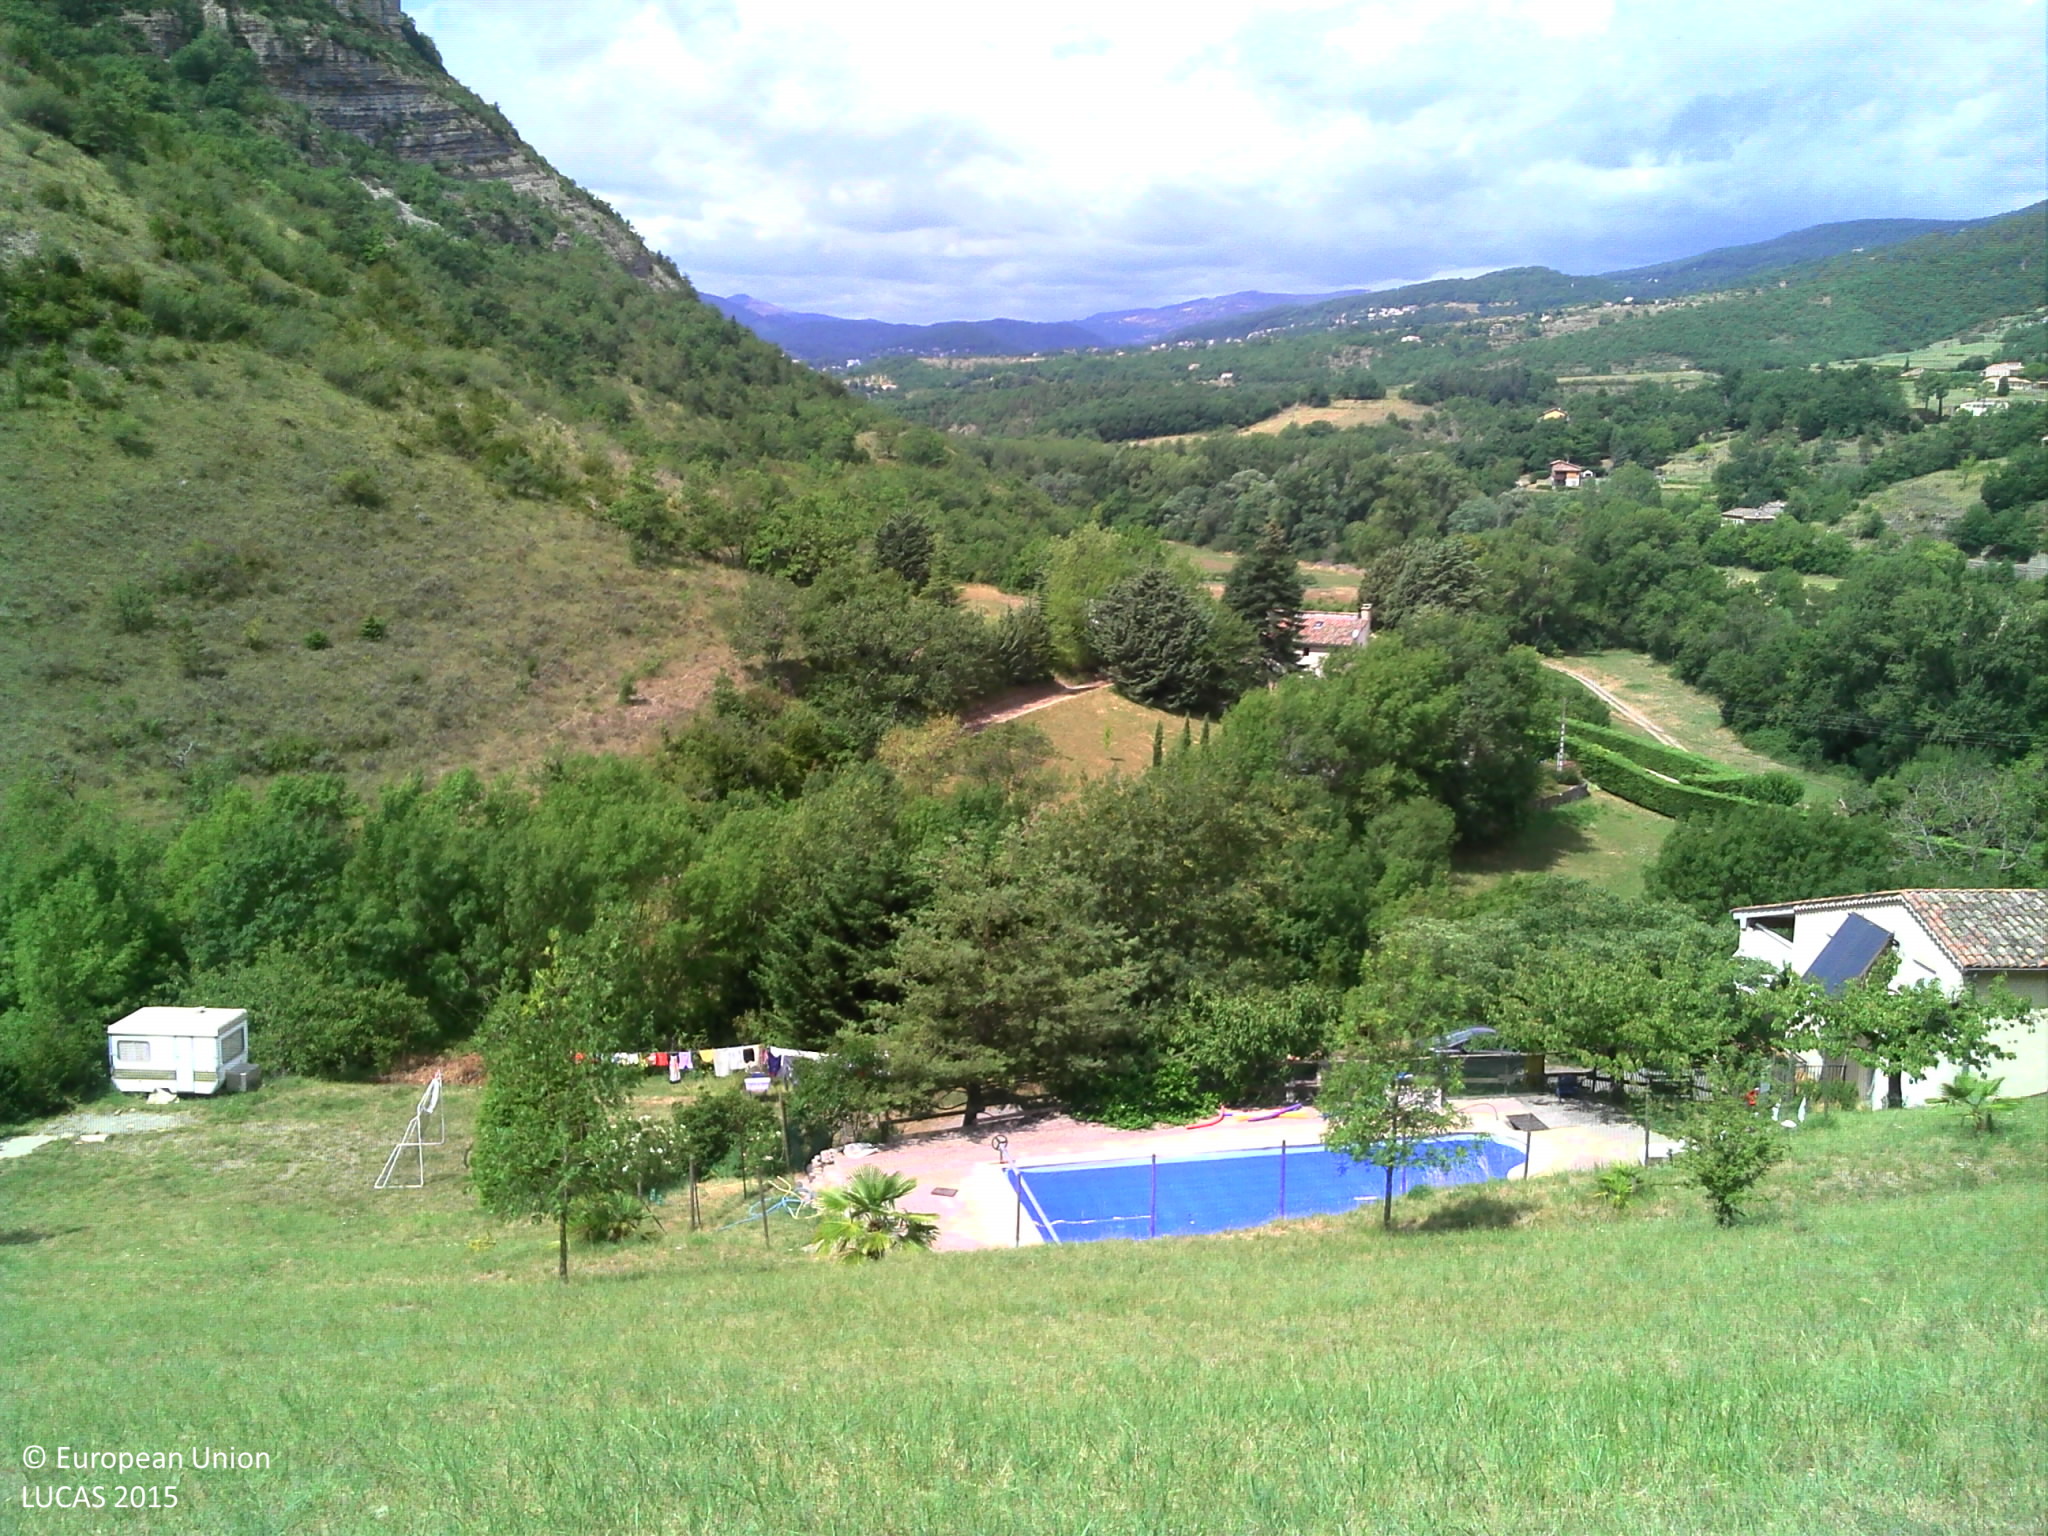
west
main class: Woodland
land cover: Broadleaved woodland
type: broadleaved evergreen forest
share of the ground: > 75 %
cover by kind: broadleaved forest trees 100 %
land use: Semi-natural and natural areas not in use
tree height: > 5 m
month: July
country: FR
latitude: 44.7373
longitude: 4.6643
